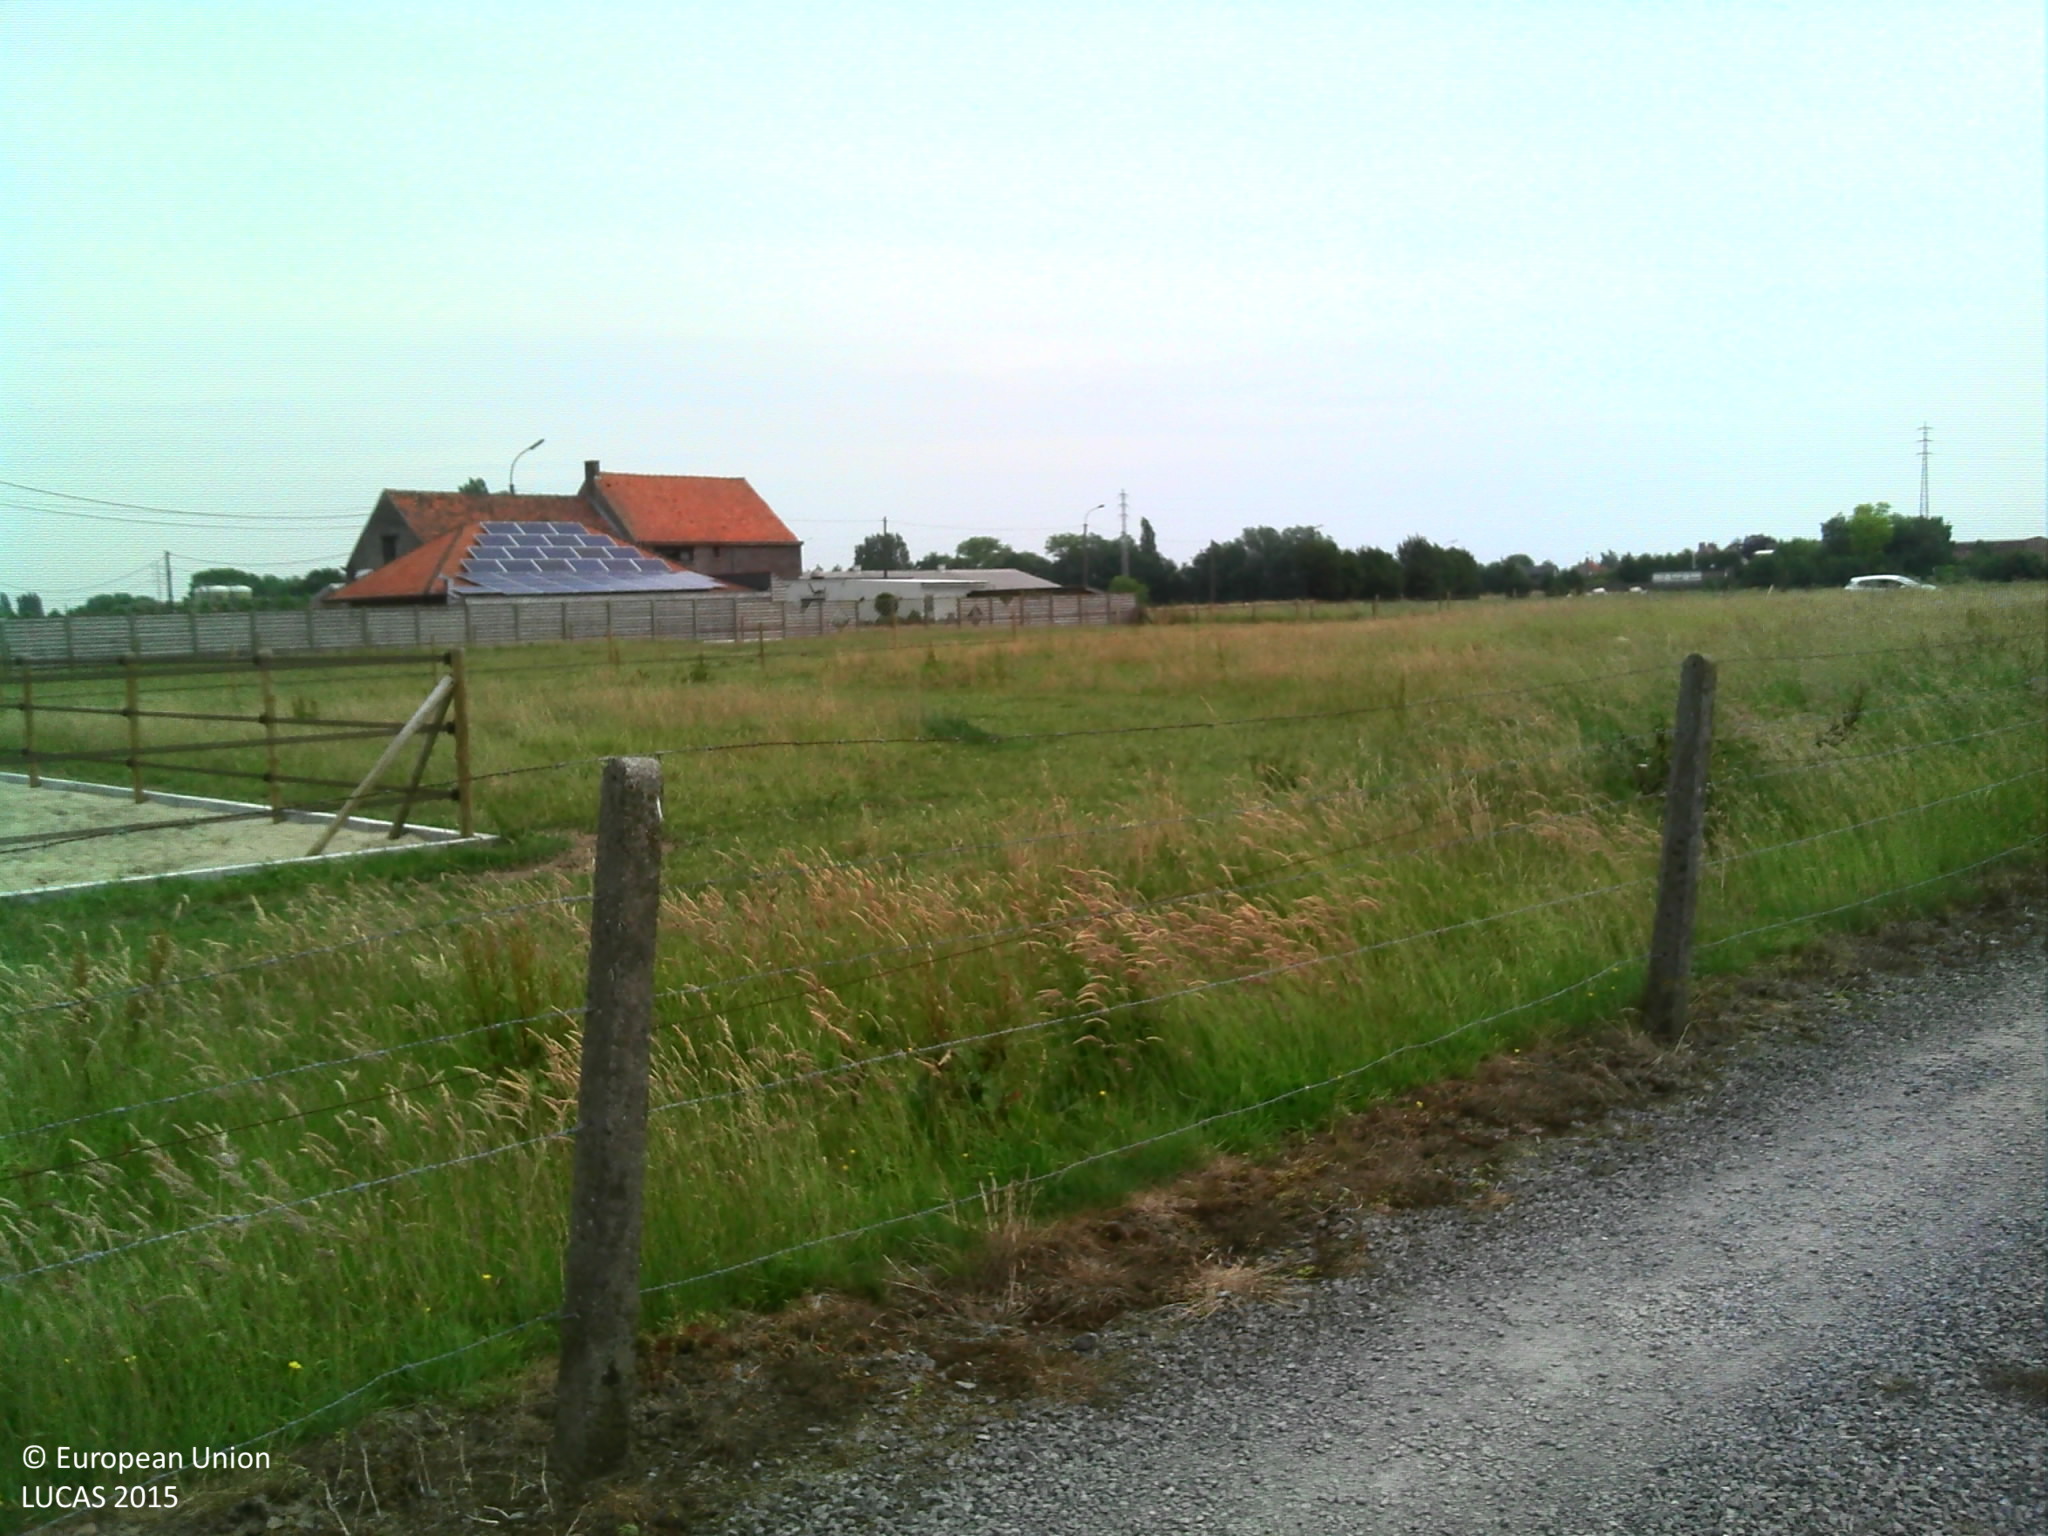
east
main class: Grassland
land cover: Grassland without tree/shrub cover
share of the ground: > 75 %
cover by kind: herbaceous plants 100 %
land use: Agriculture (excluding fallow land and kitchen gardens)
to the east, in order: Grassland without tree/shrub cover; Fences; Grass margins; Ditches and canals; Abandoned hedges; Fences; Grassland without tree/shrub cover; Fences; Grassland without tree/shrub cover; Fences; Tracks; Fences; Grassland without tree/shrub cover; Fences; Grassland without tree/shrub cover; Fences; Grass margins; Paved roads, cycling and walking lanes; Grass margins; Fences; Grassland without tree/shrub cover
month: June
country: BE
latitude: 50.9509
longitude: 3.4297
